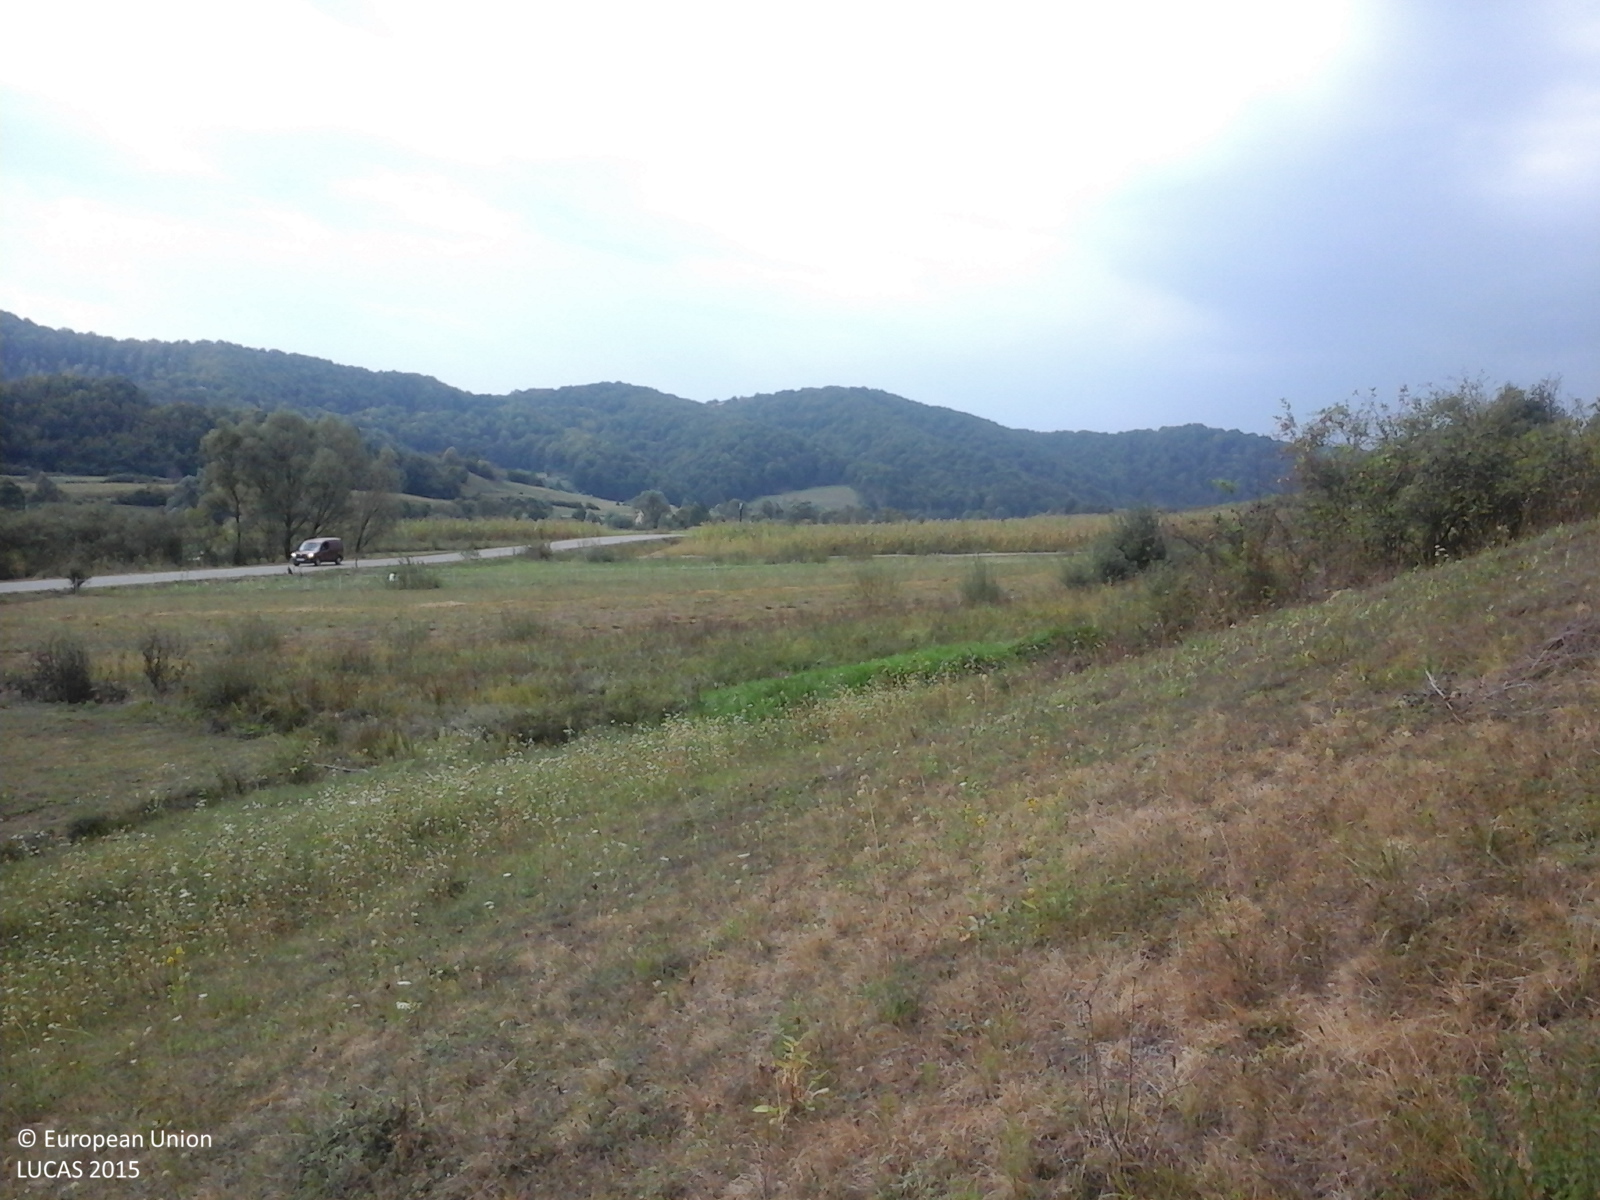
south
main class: Grassland
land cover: Grassland with sparse tree/shrub cover
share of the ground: > 75 %
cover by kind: herbaceous plants 90 %, broadleaved forest trees 5 %, shrubs 5 %
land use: Agriculture (excluding fallow land and kitchen gardens)
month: September
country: RO
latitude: 47.4950
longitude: 23.9536
